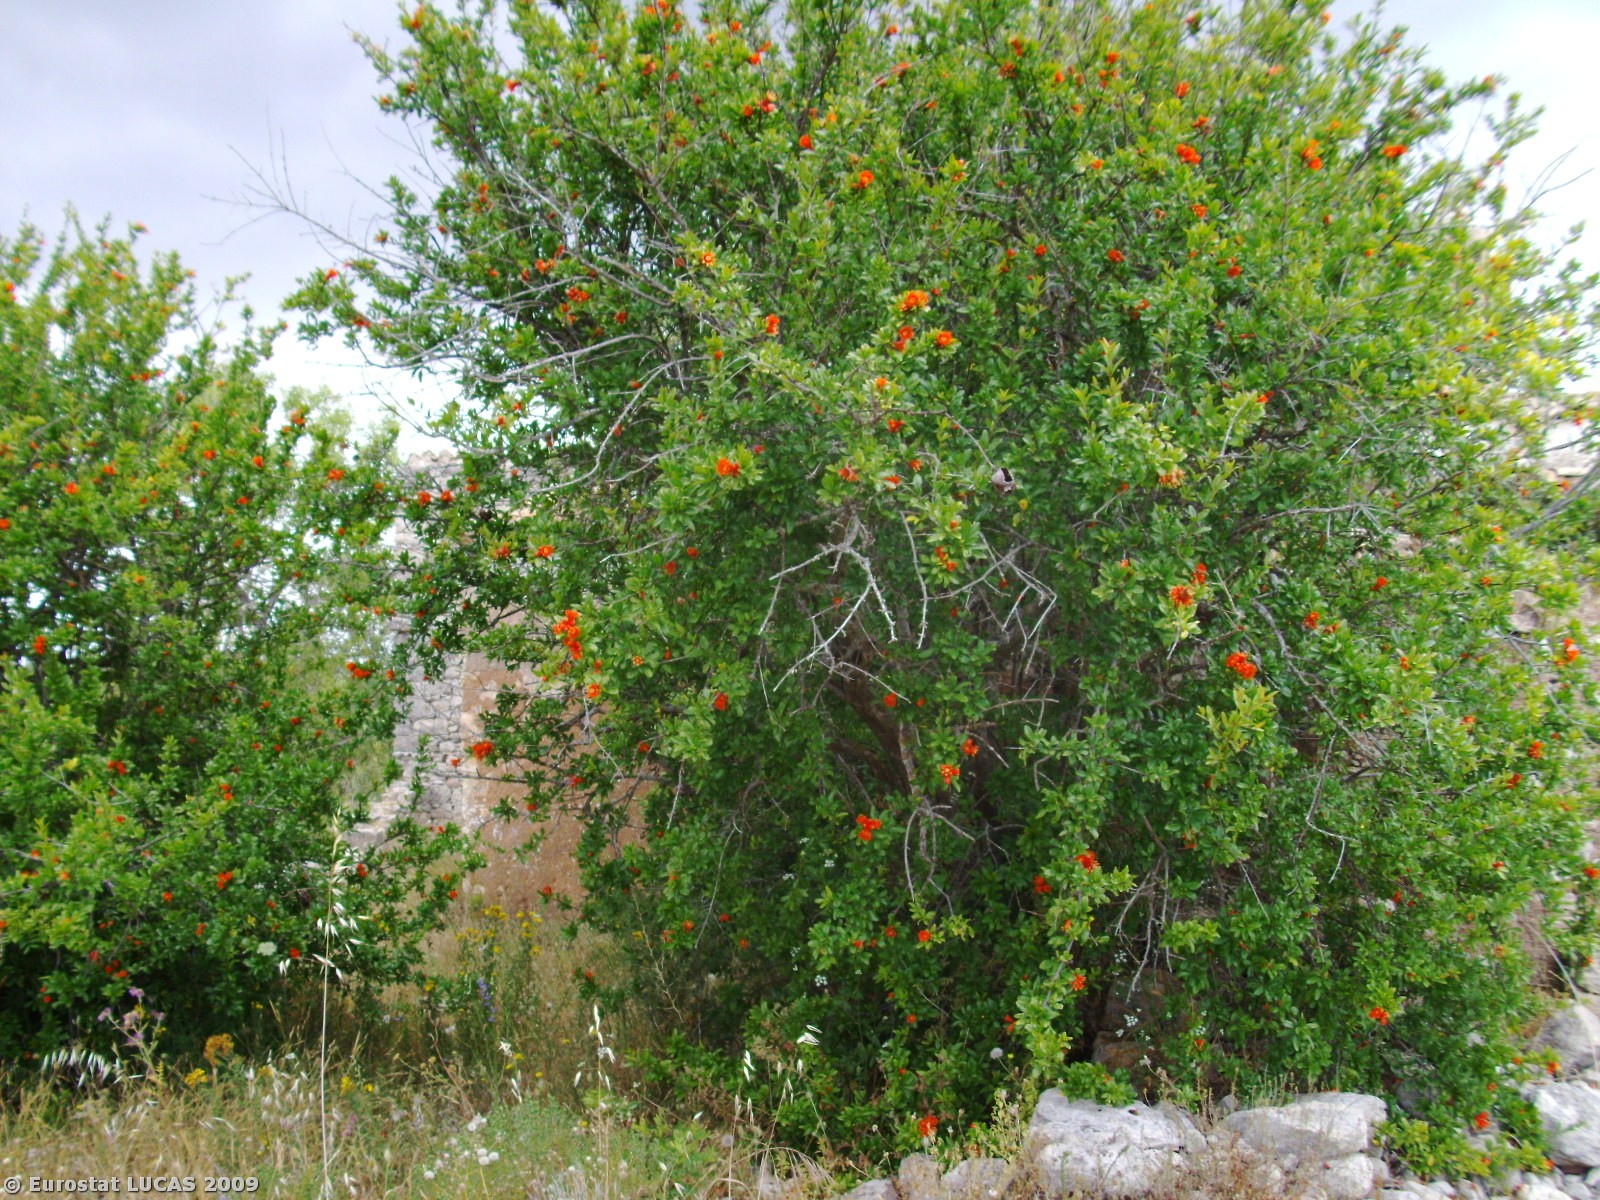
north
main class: Grassland
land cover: Spontaneously vegetated surfaces
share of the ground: 25 - 50 %
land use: Unused
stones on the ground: 25 - 50 %
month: May
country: PT
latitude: 37.1510
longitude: -8.1553
